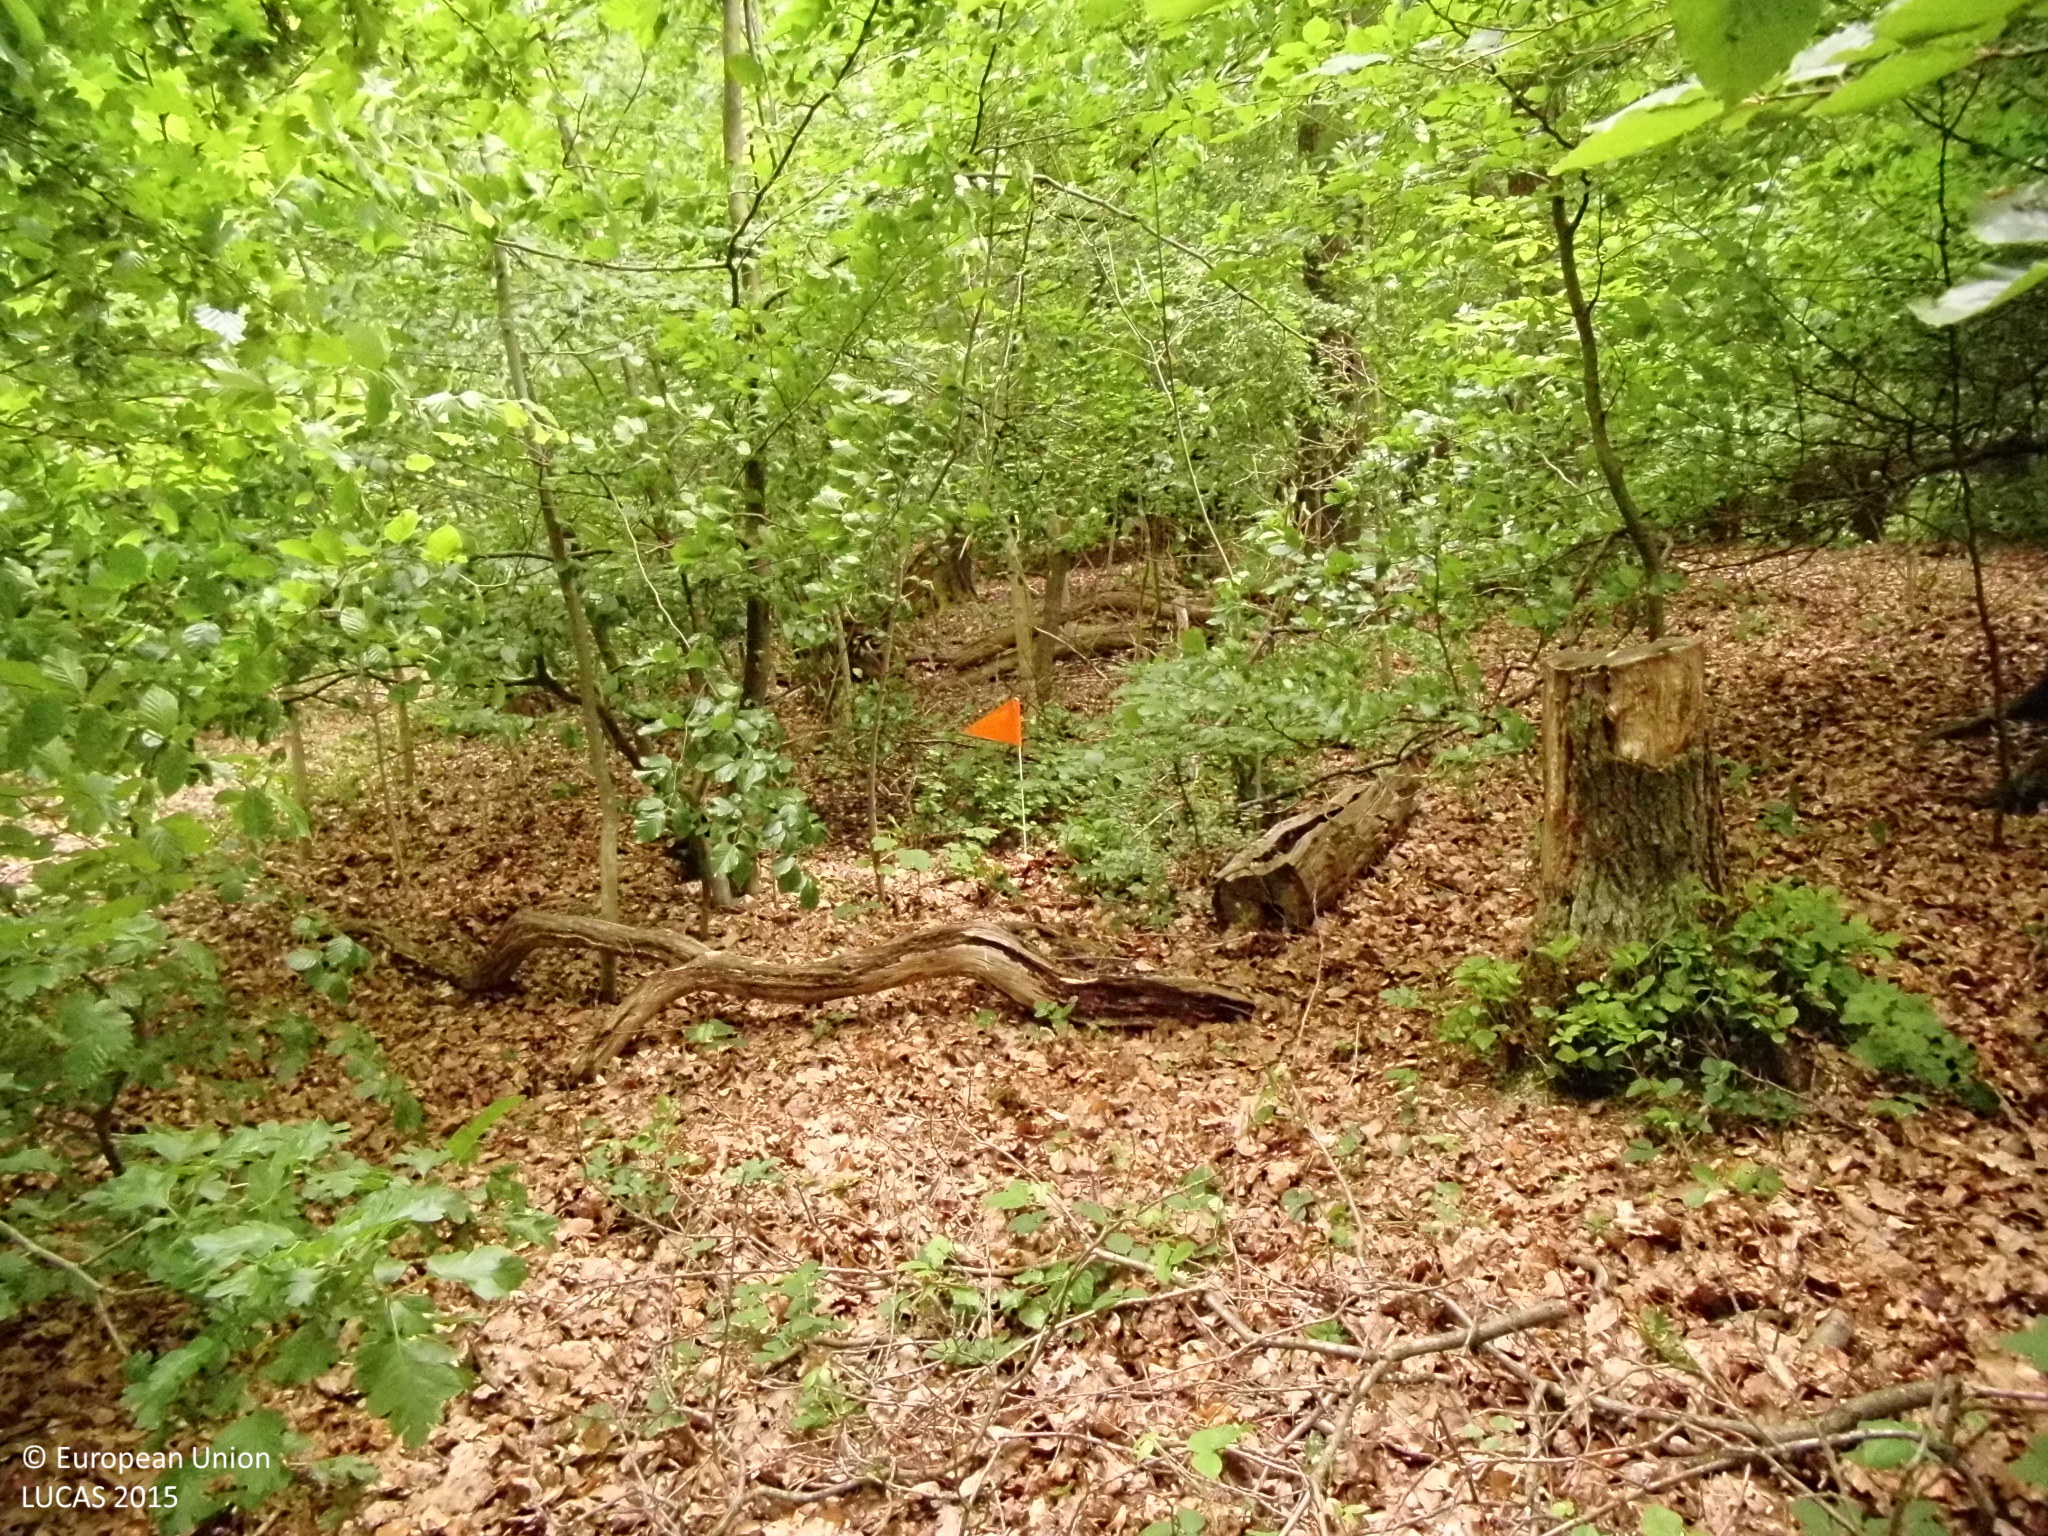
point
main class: Woodland
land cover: Broadleaved woodland
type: mesophytic deciduous forest
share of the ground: > 75 %
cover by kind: broadleaved forest trees 95 %, unconsolidated bare surface 5 %
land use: Forestry
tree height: > 5 m
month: May
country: DE
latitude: 51.3426
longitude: 7.4305
